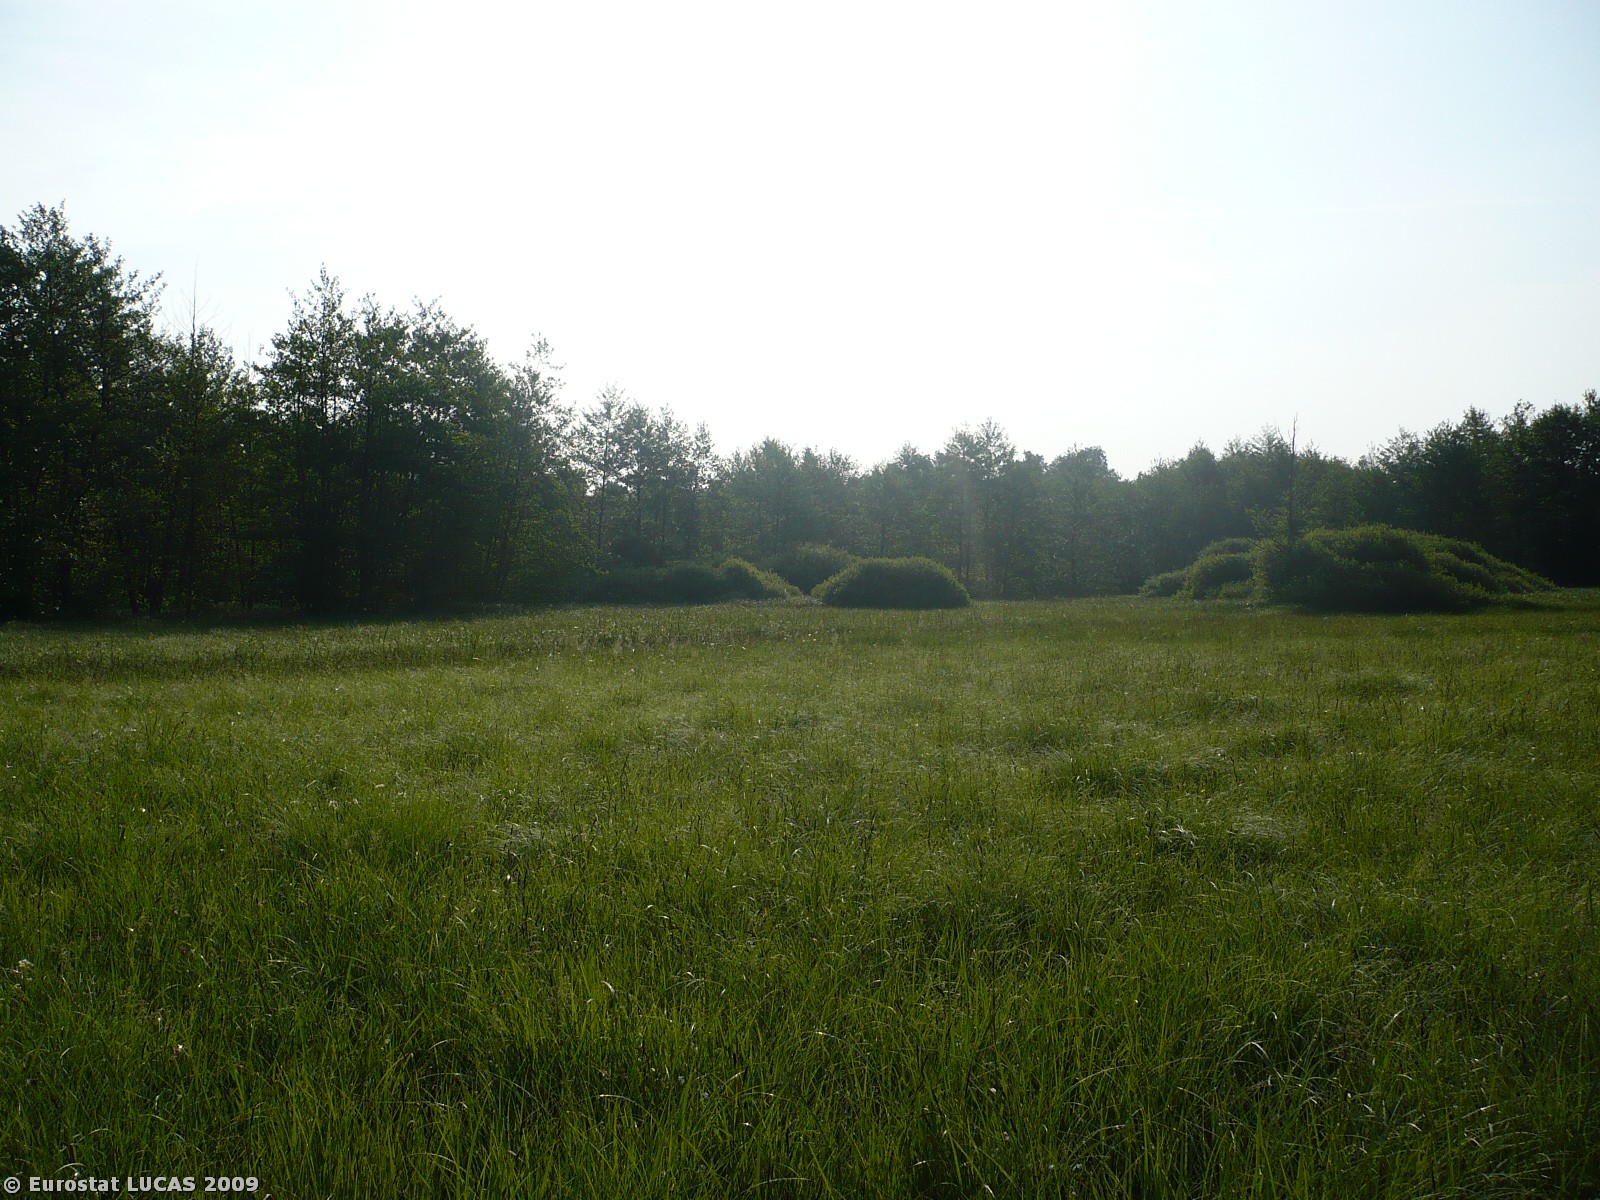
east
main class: Shrubland
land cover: Shrubland with sparse tree cover
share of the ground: > 75 %
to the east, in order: Shrubland with sparse tree cover; Grassland with sparse tree/shrub cover; Broadleaved woodland
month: May
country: SI
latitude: 45.8927
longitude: 15.3453
